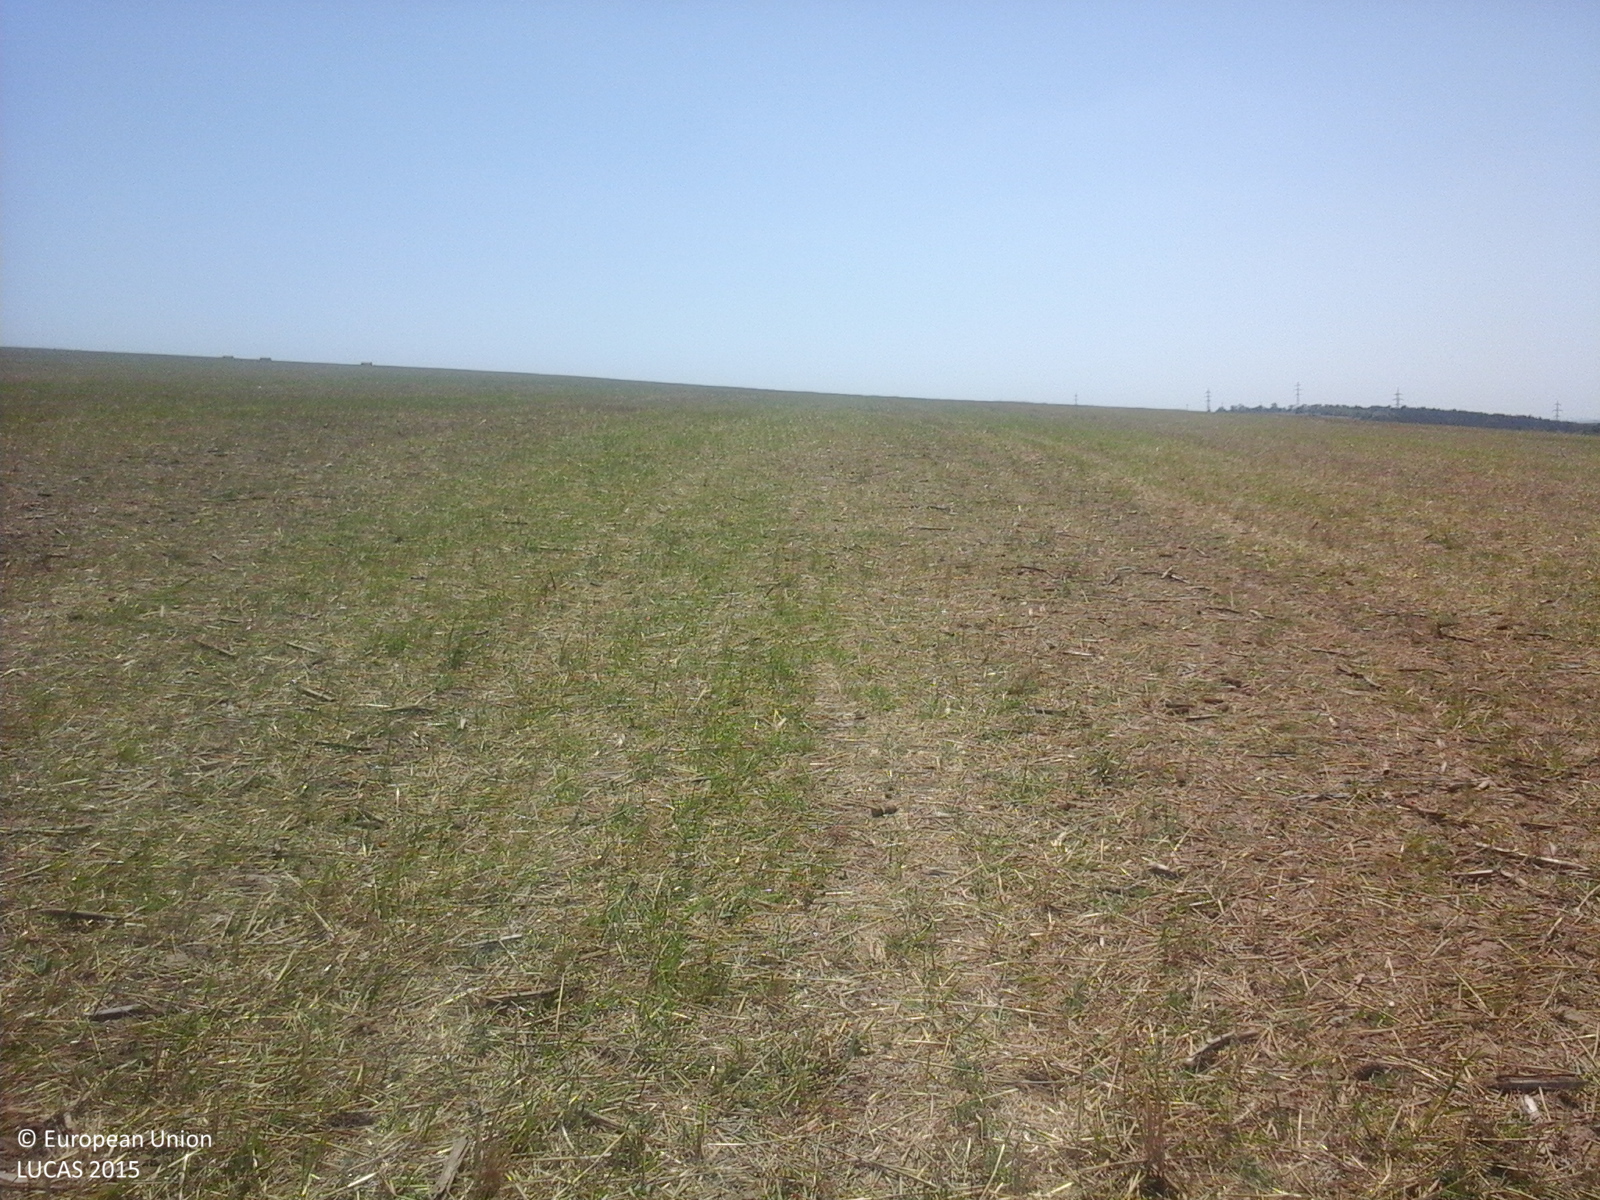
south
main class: Cropland
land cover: Common wheat
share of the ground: 10 - 25 %
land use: Agriculture (excluding fallow land and kitchen gardens)
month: August
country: RO
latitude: 44.4721
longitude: 28.1254
